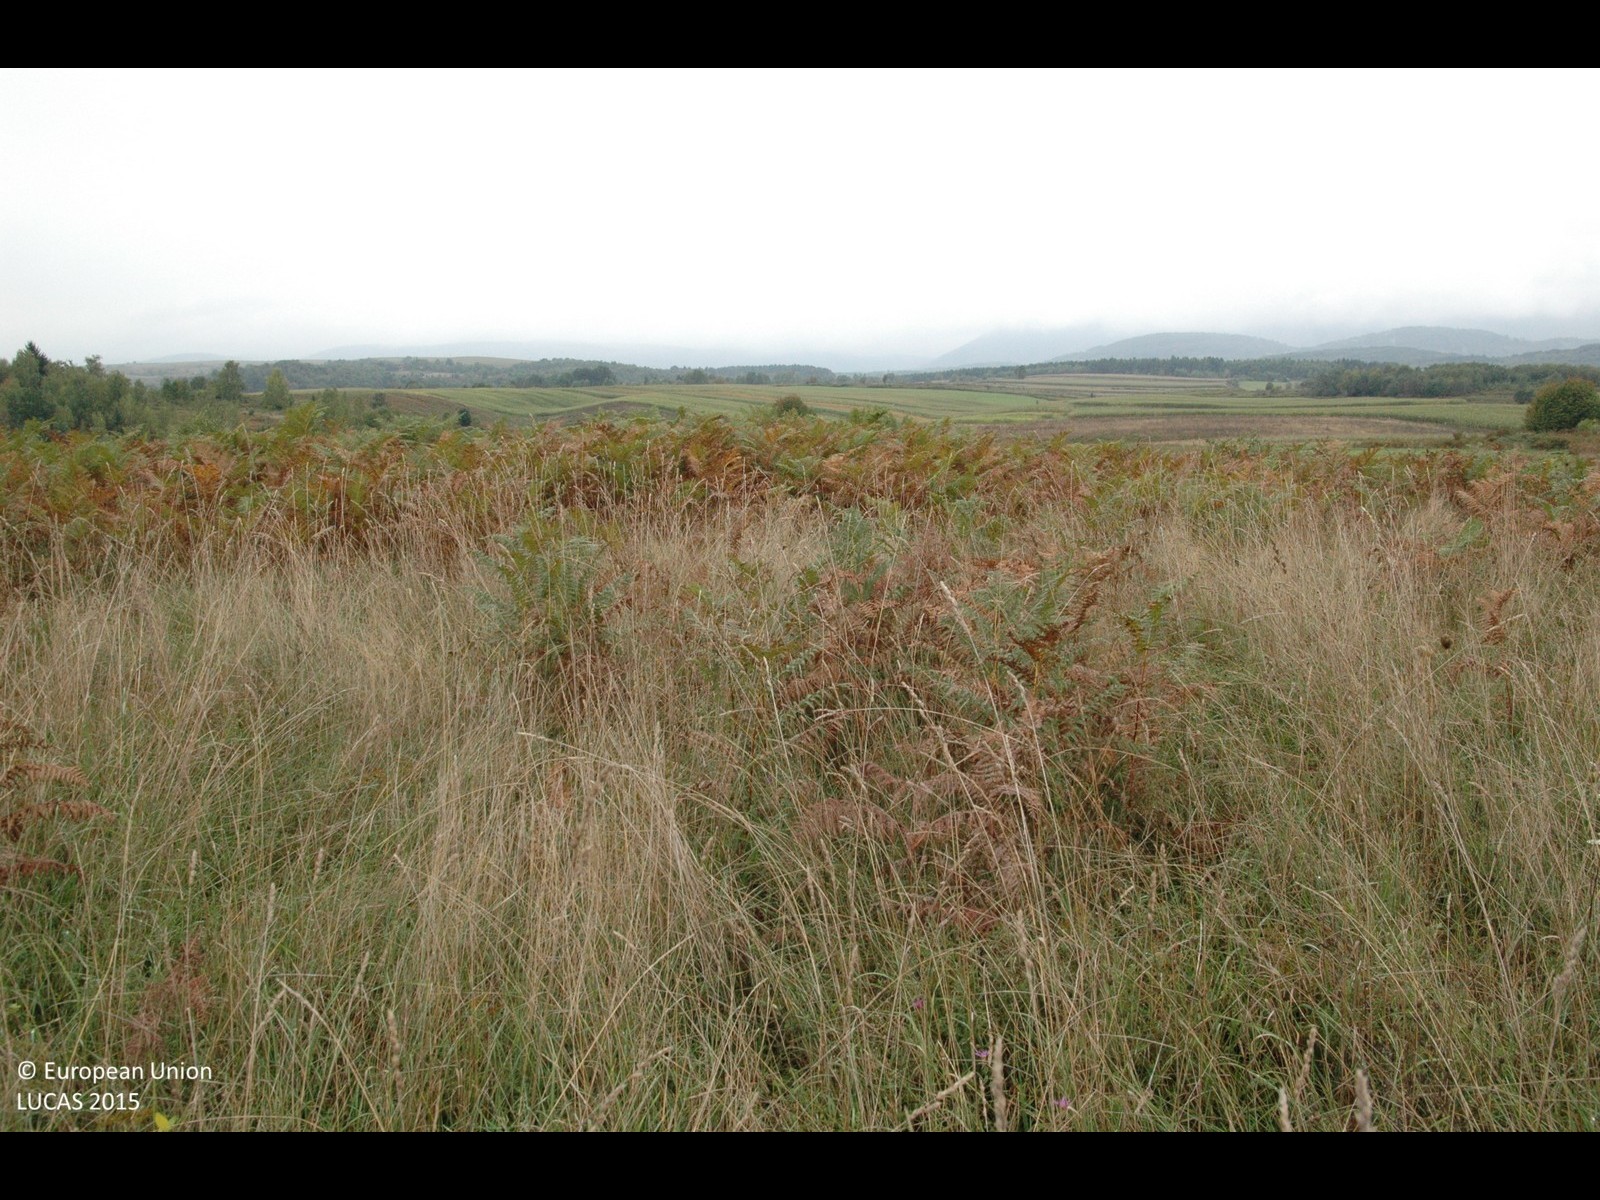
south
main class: Grassland
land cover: Grassland without tree/shrub cover
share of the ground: > 75 %
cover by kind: herbaceous plants 100 %
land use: Semi-natural and natural areas not in use
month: September
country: HR
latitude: 44.9910
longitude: 15.6647
